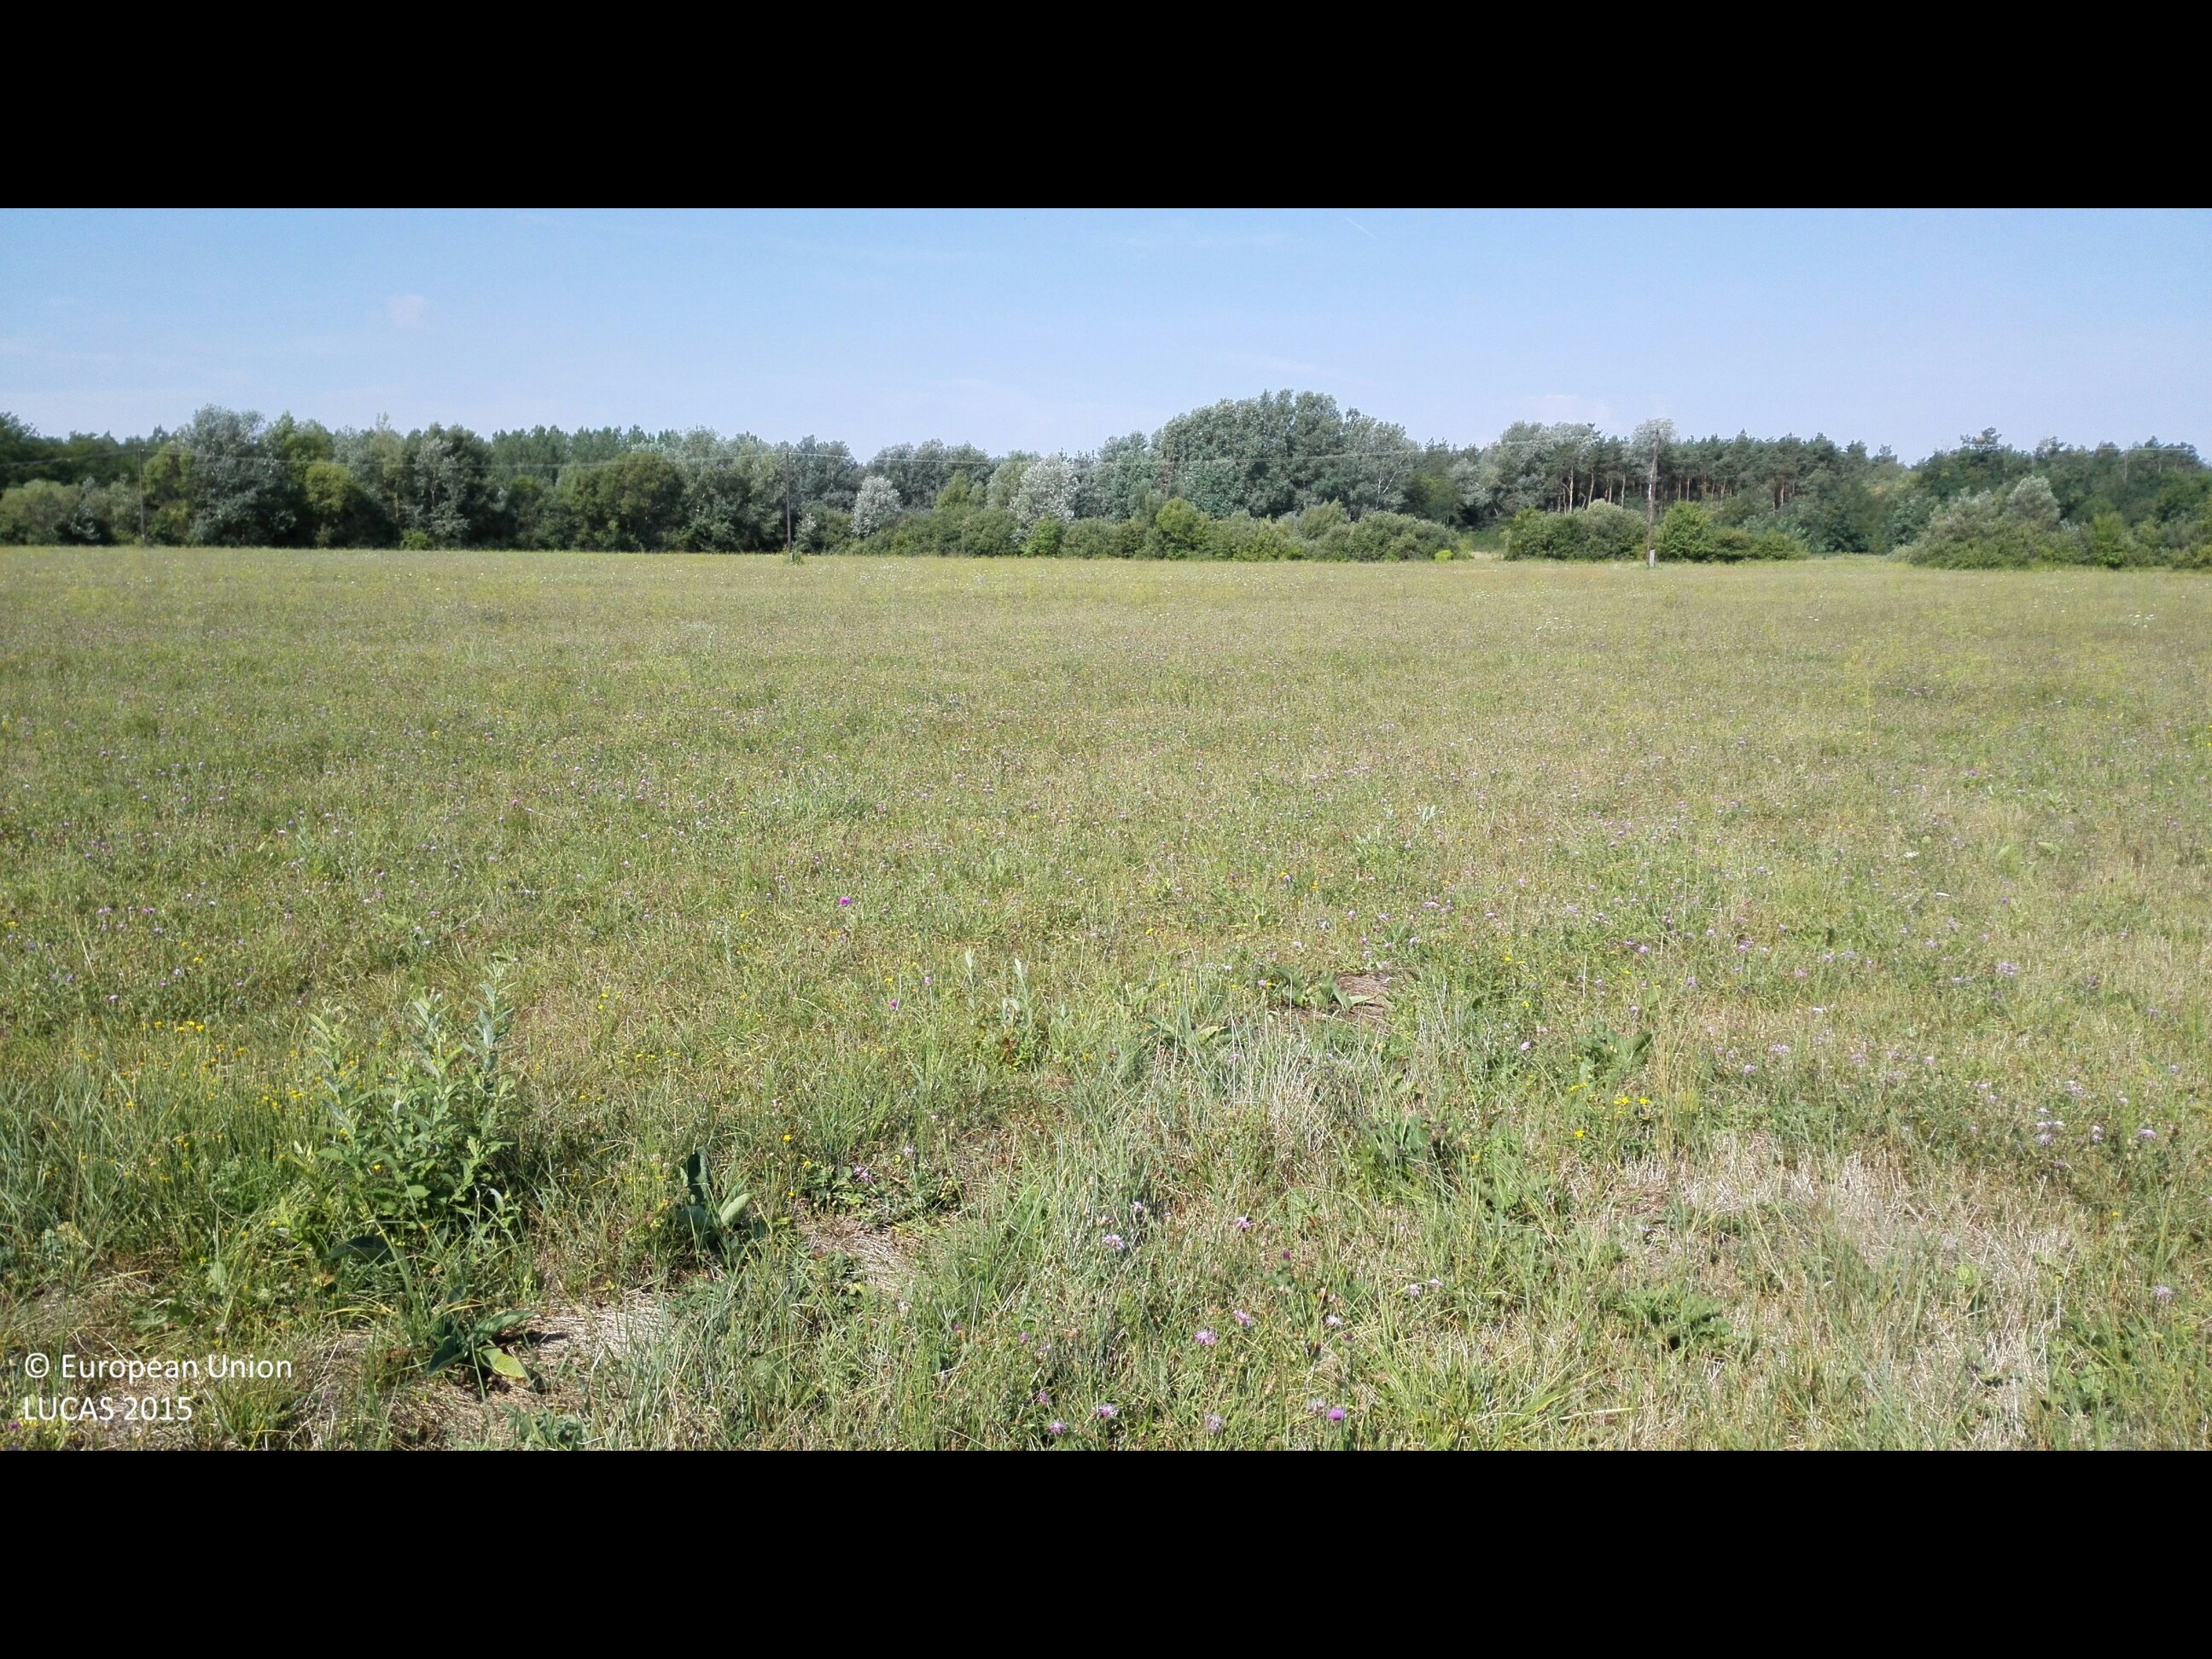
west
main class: Grassland
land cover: Grassland without tree/shrub cover
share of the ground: > 75 %
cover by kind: herbaceous plants 100 %
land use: Agriculture (excluding fallow land and kitchen gardens)
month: August
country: HU
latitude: 47.4672
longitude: 21.7339
